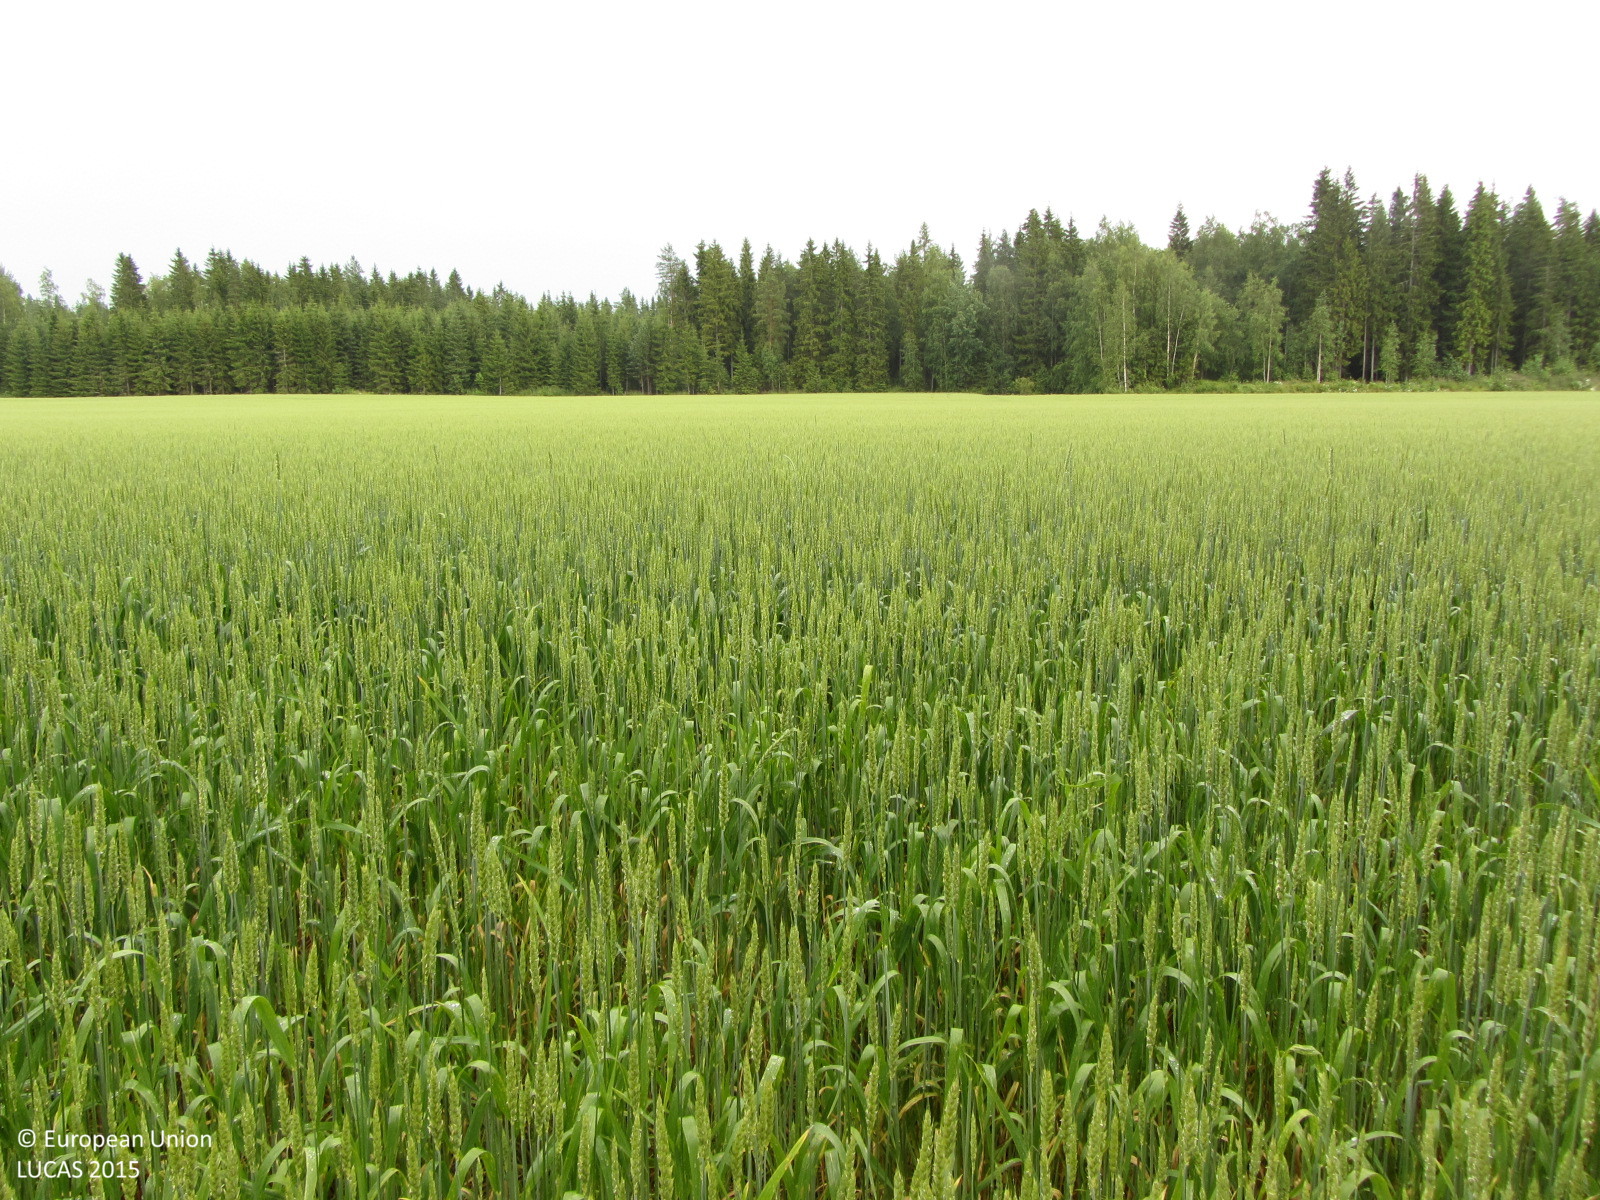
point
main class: Cropland
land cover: Common wheat
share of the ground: > 75 %
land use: Agriculture (excluding fallow land and kitchen gardens)
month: July
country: FI
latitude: 60.5704
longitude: 24.6131
